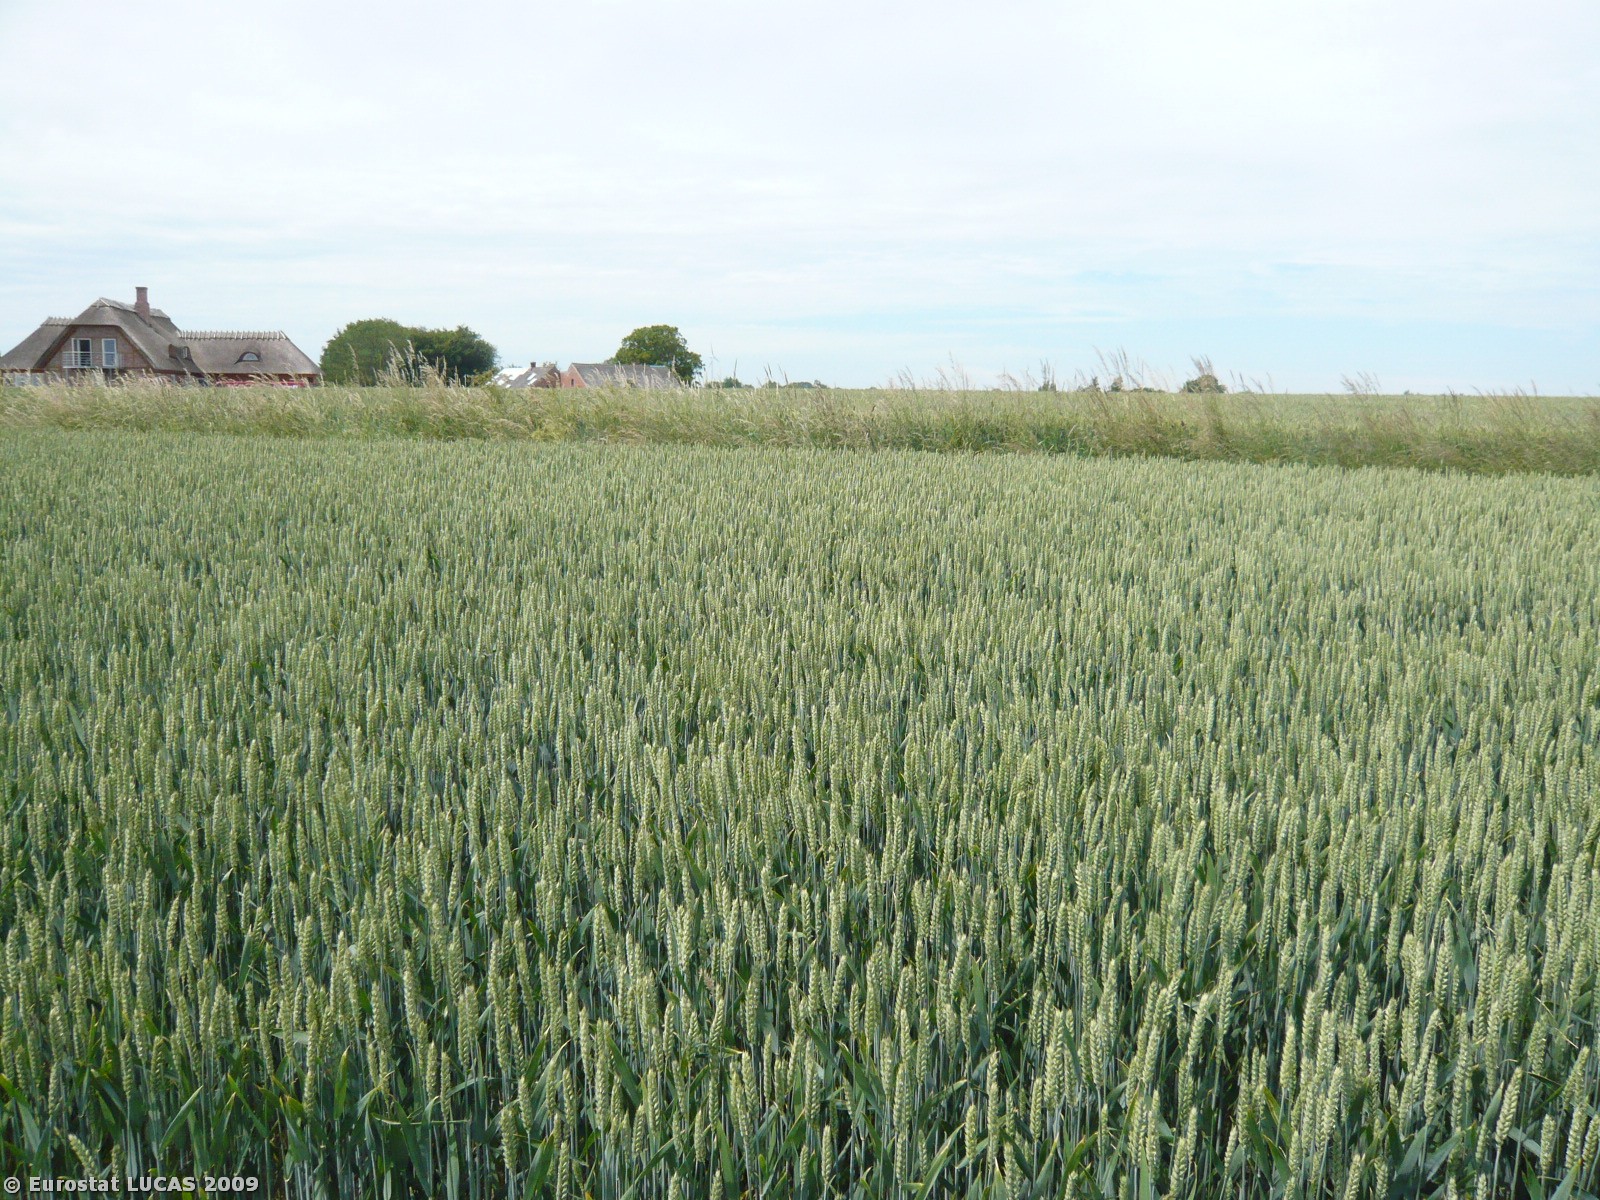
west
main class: Cropland
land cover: Common wheat
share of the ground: > 75 %
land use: Agriculture (excluding fallow land and kitchen gardens)
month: June
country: DK
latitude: 55.1968
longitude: 10.7691
